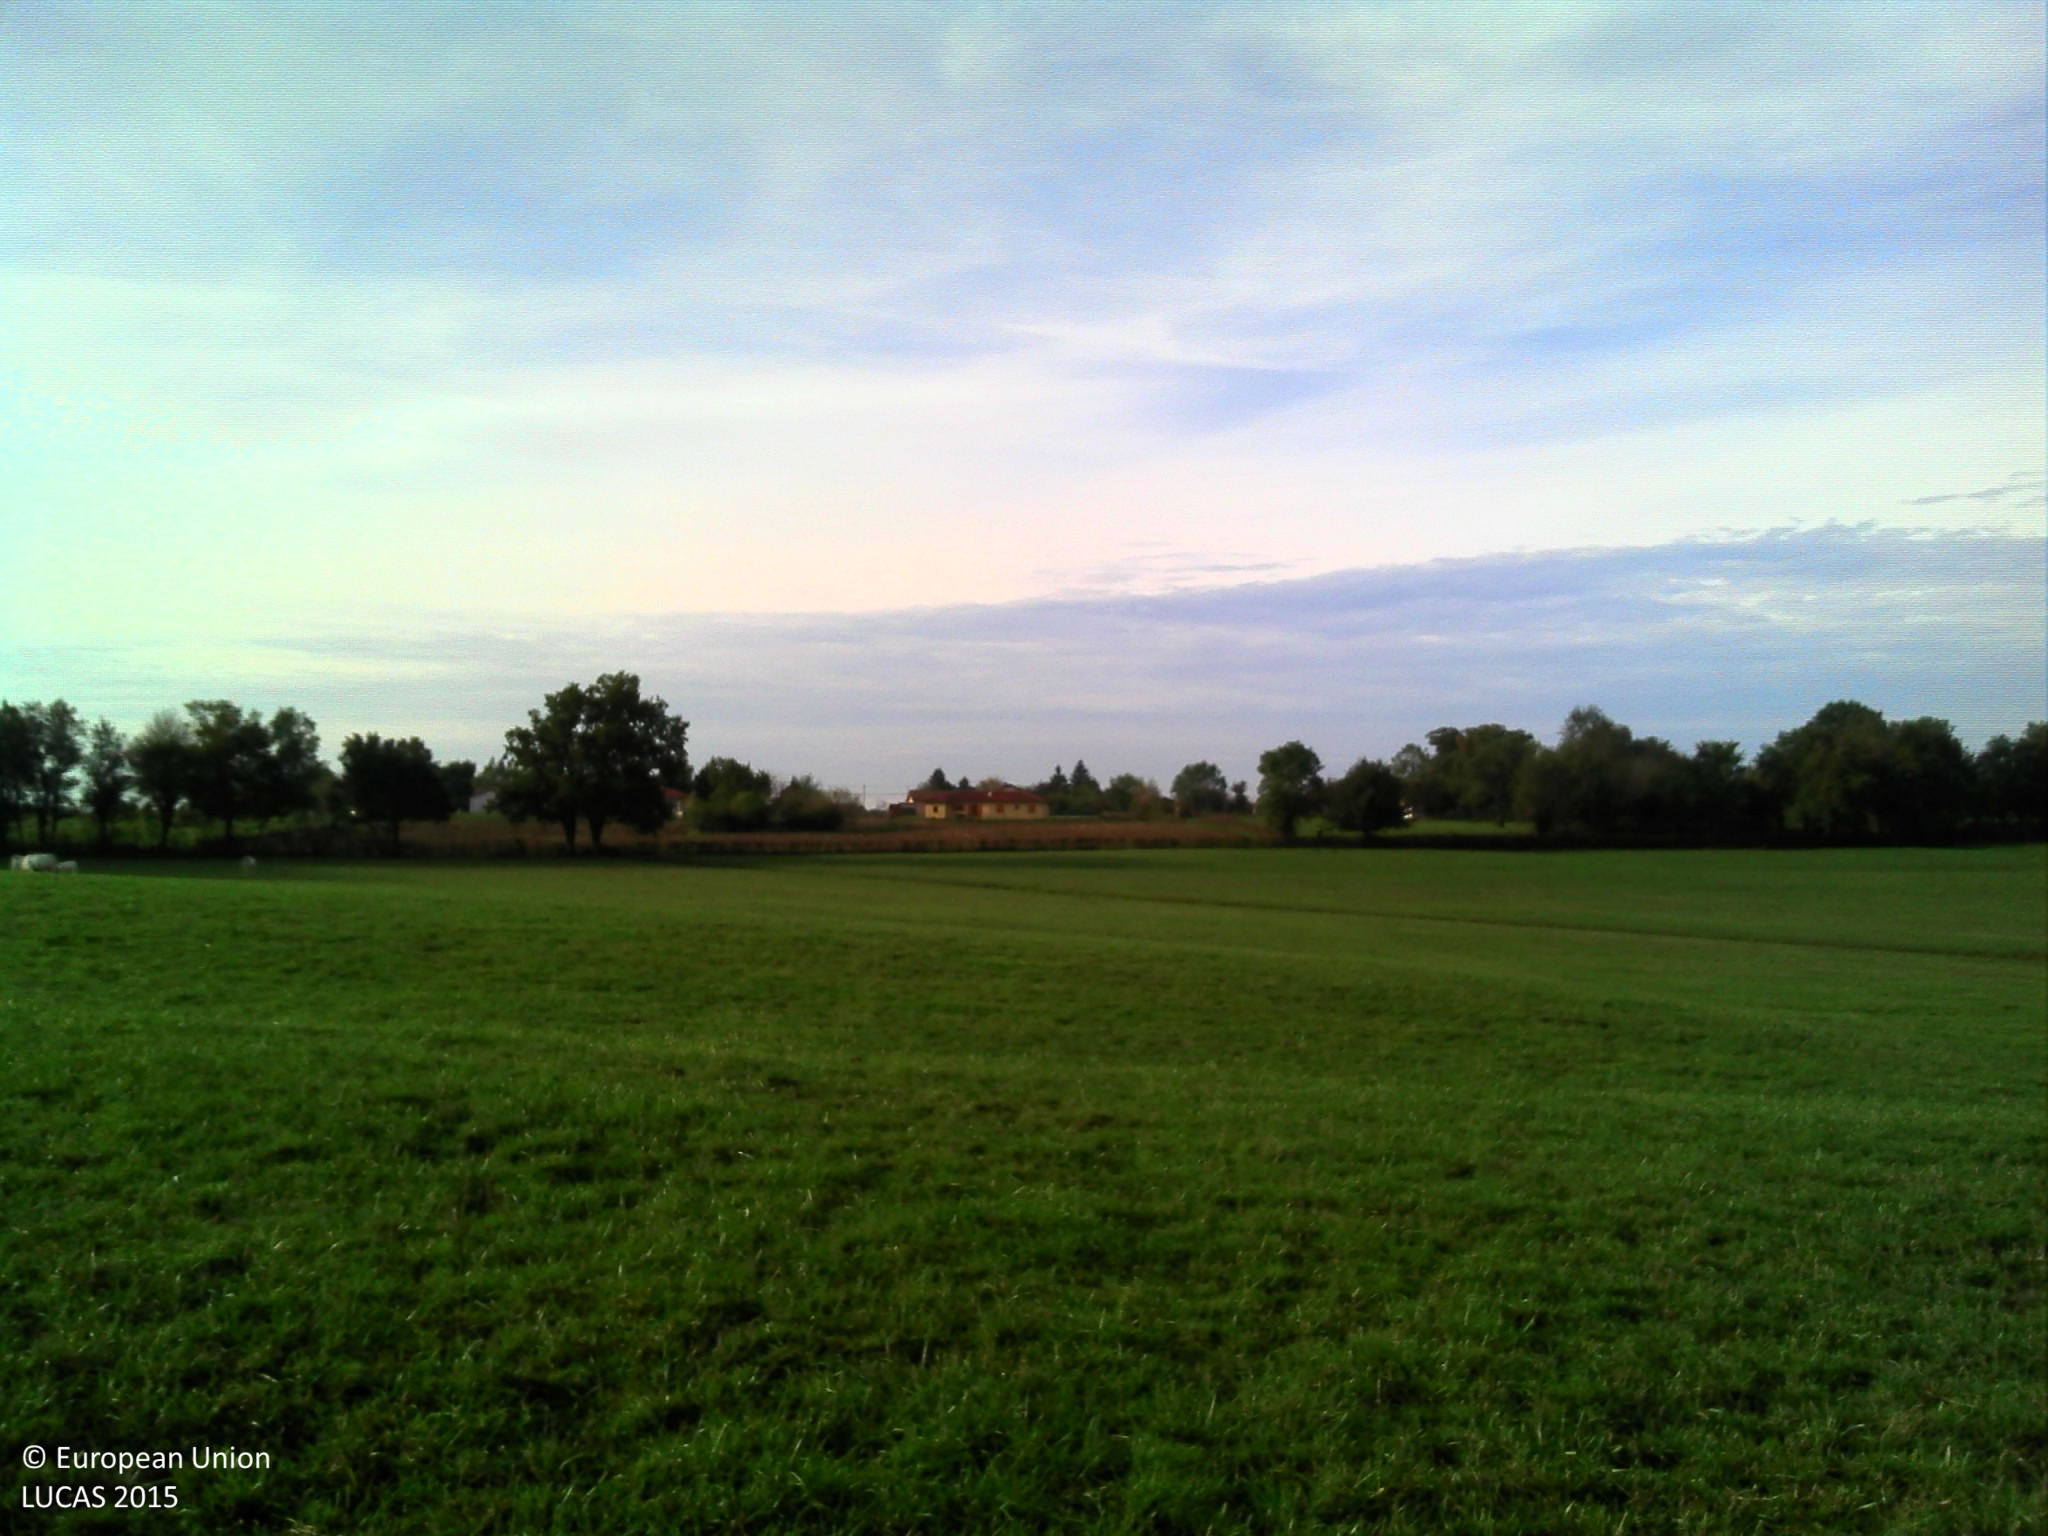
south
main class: Grassland
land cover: Grassland without tree/shrub cover
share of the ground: > 75 %
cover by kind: herbaceous plants 100 %
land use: Agriculture (excluding fallow land and kitchen gardens)
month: October
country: FR
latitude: 46.4145
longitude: 4.9935
